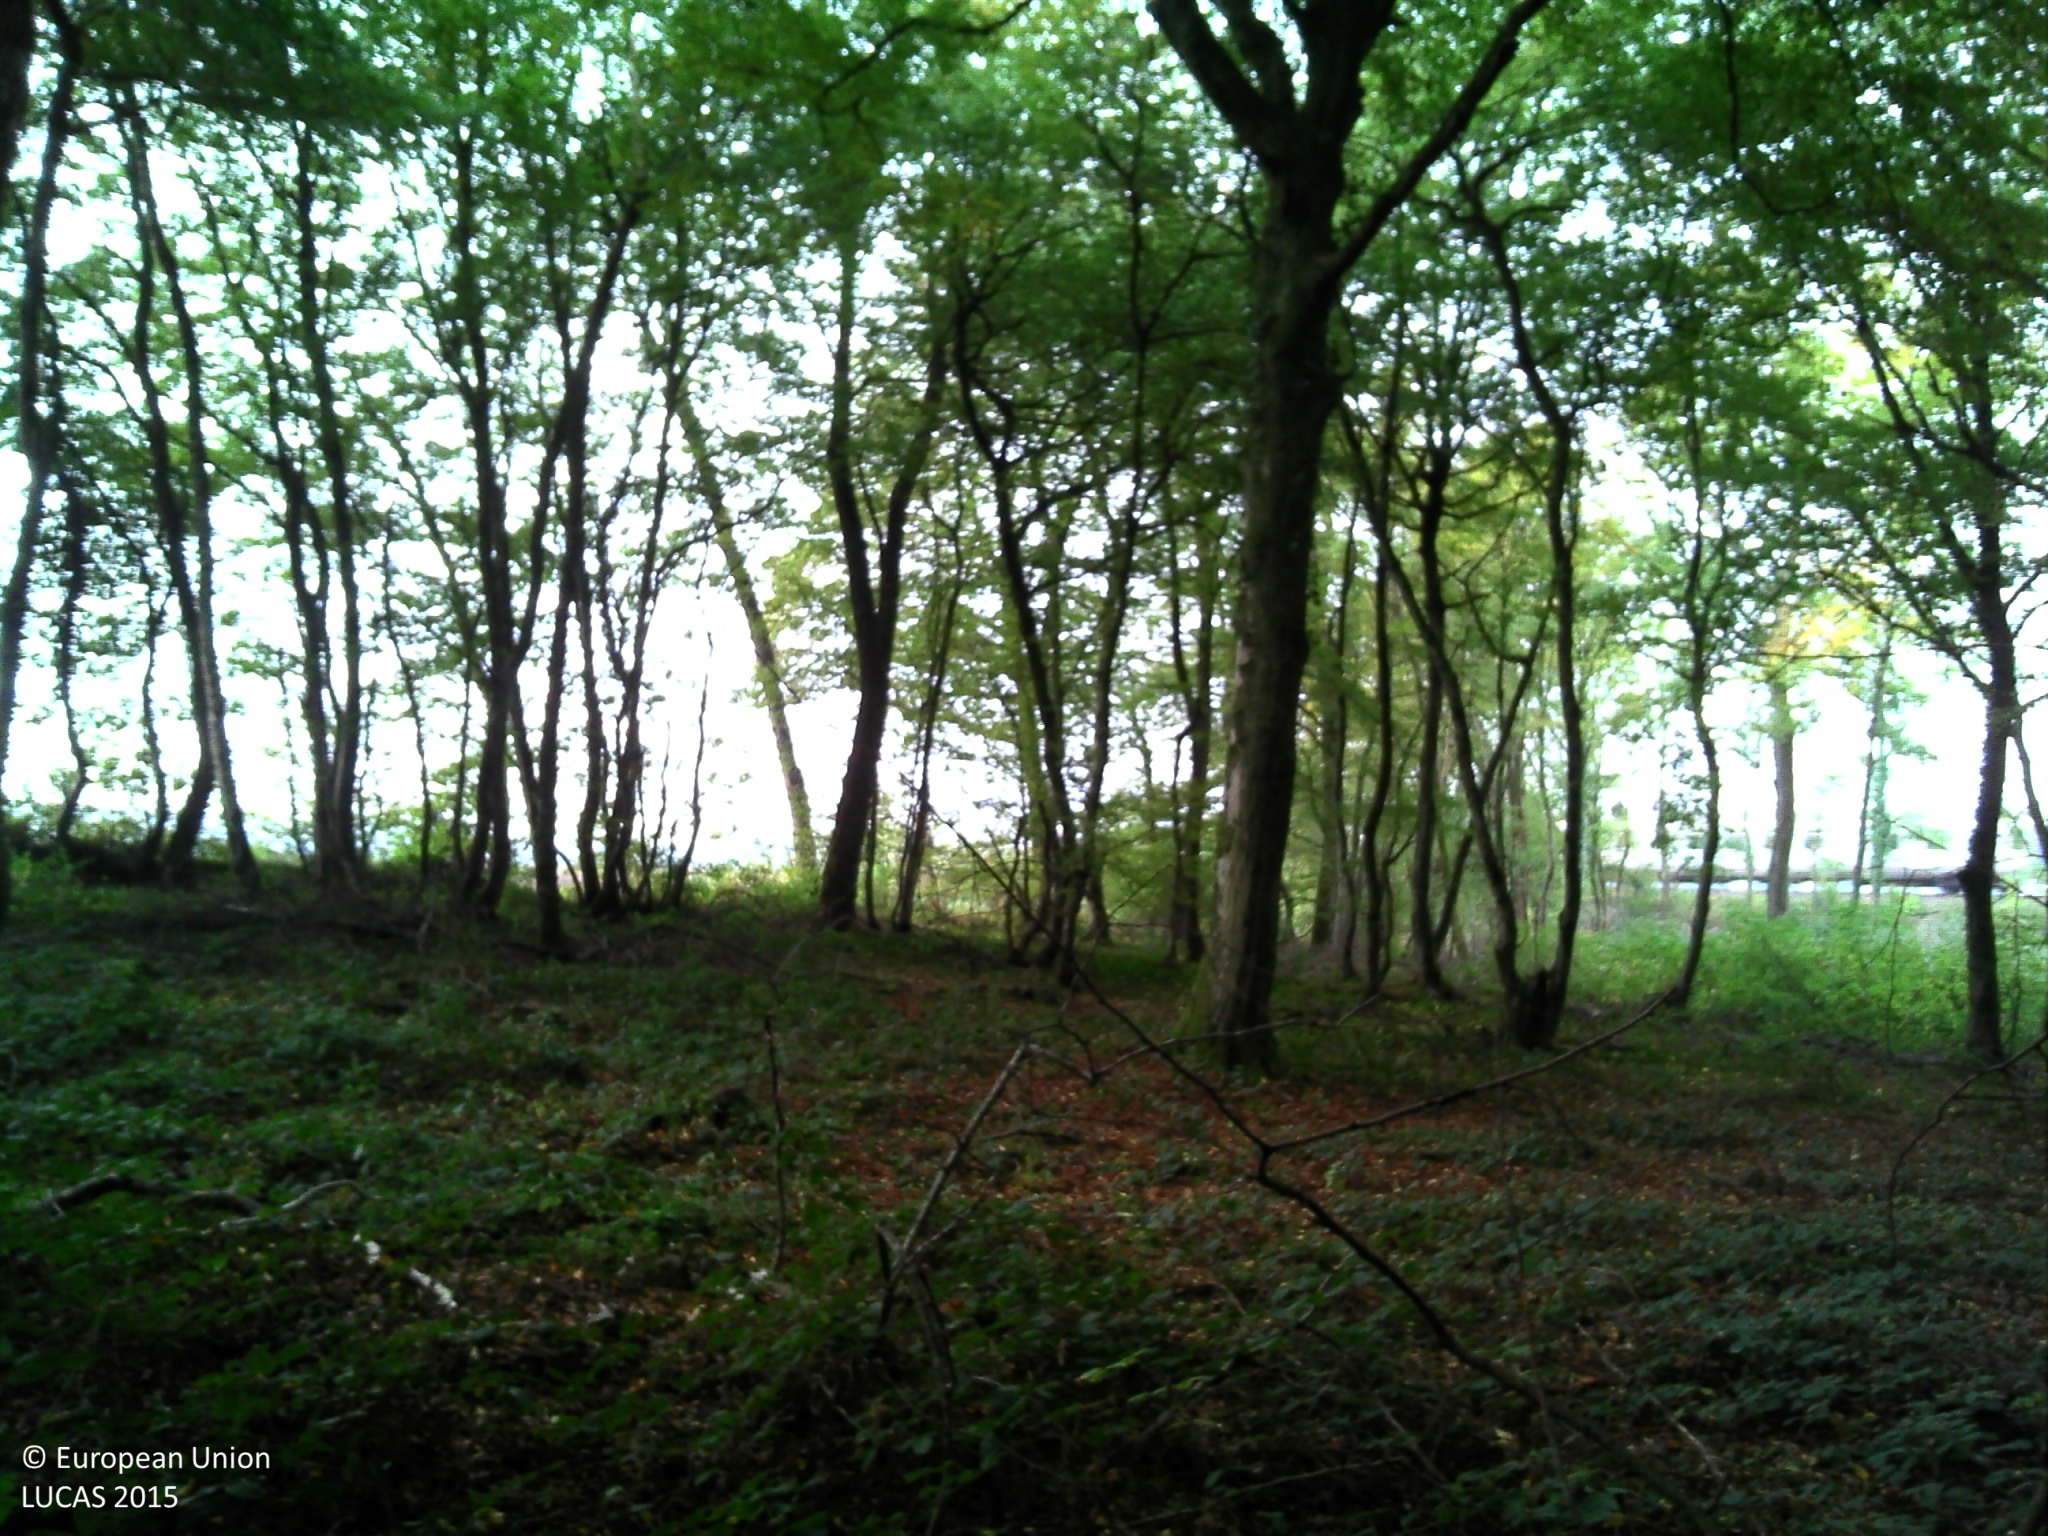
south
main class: Woodland
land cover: Broadleaved woodland
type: mesophytic deciduous forest
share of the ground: > 75 %
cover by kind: broadleaved forest trees 90 %, herbaceous plants 10 %
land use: Forestry
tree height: > 5 m
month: October
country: FR
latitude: 46.0859
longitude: 5.3088
